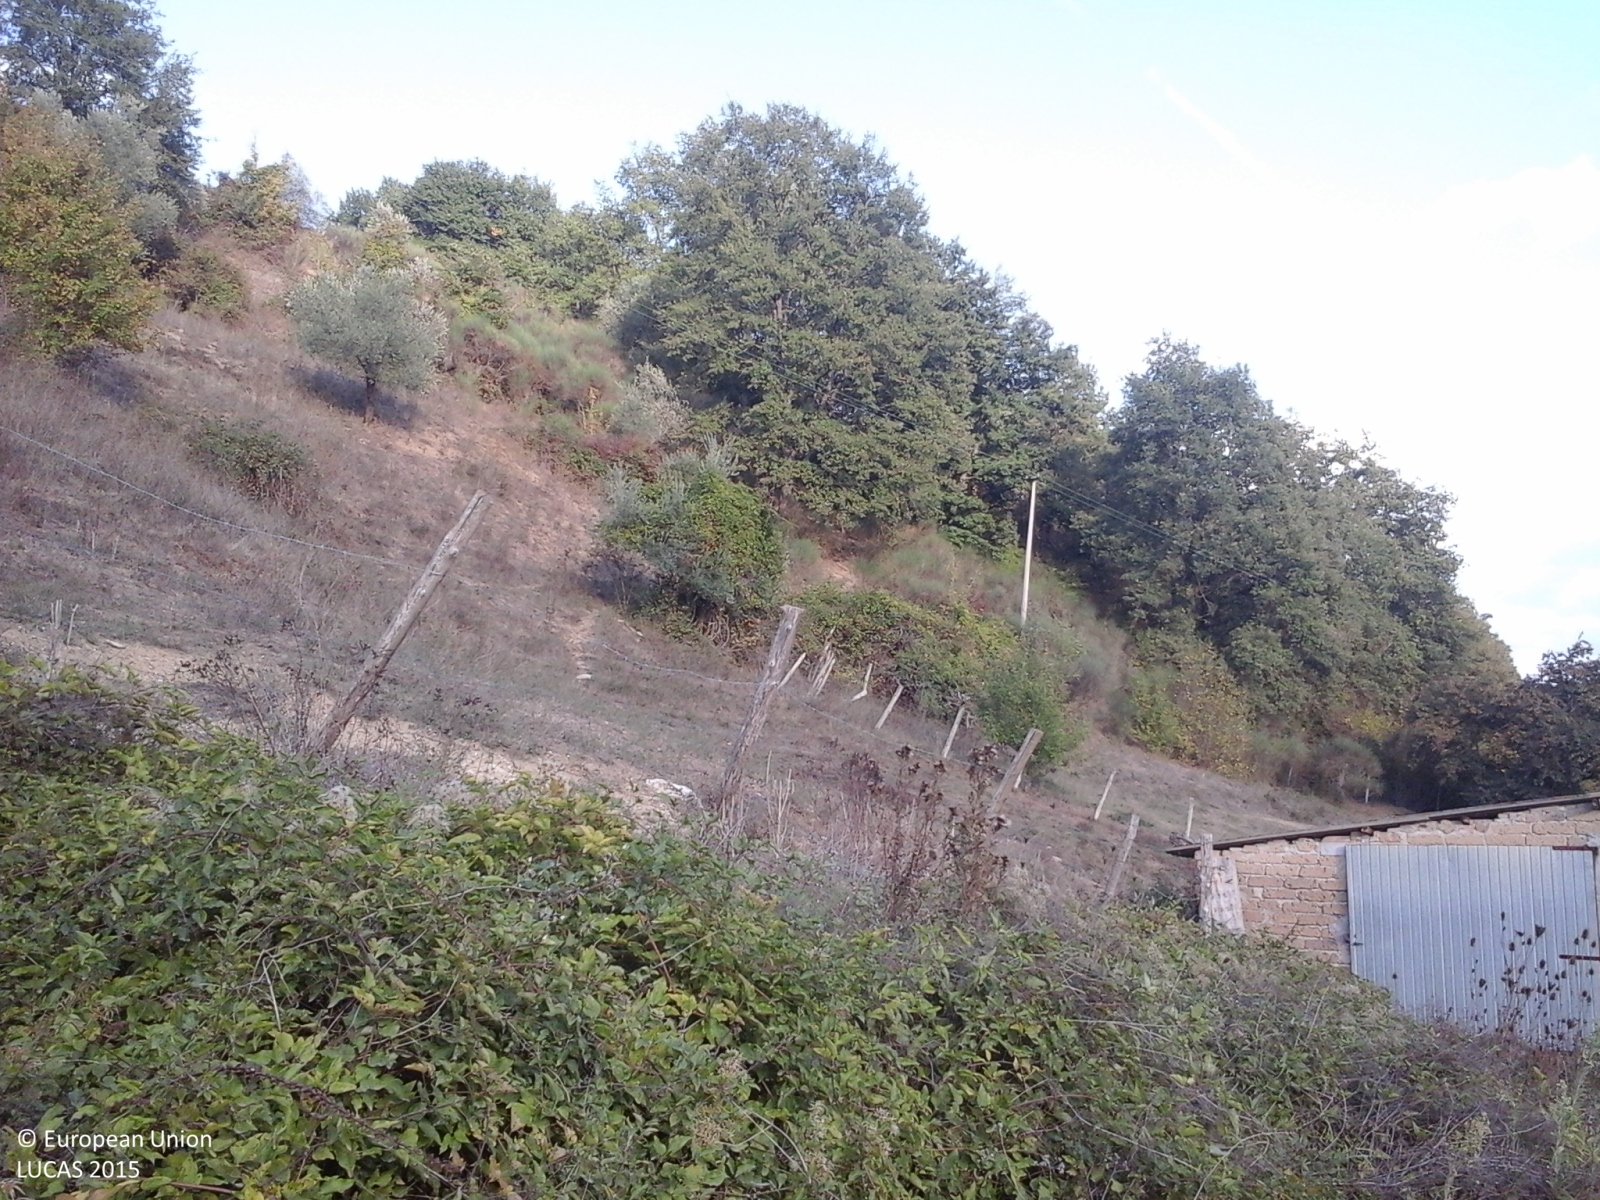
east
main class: Cropland
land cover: Olive groves
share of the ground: 25 - 50 %
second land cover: Grassland without tree/shrub cover
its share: > 75 %
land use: Agriculture (excluding fallow land and kitchen gardens)
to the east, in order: Olive groves; Grassland without tree/shrub cover; Fences; Broadleaved woodland; Grassland without tree/shrub cover
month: October
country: IT
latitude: 43.2427
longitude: 12.2719
